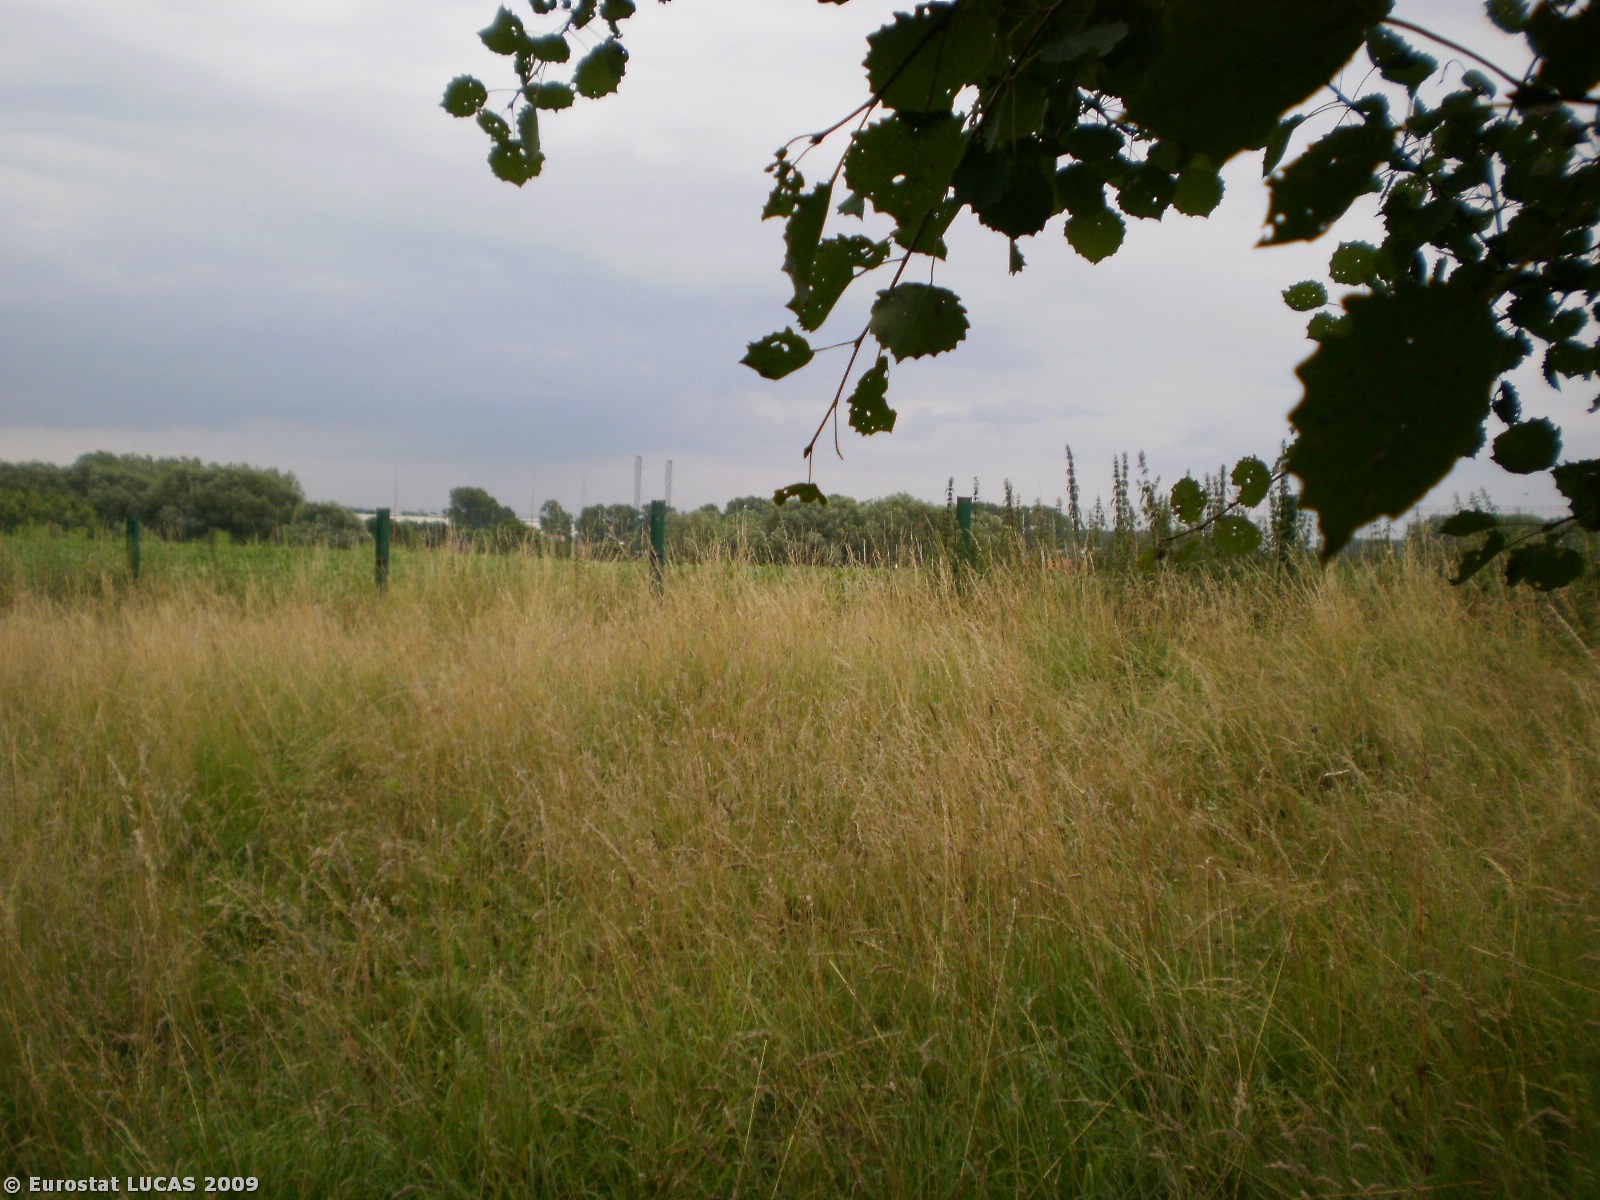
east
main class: Grassland
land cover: Grassland without tree/shrub cover
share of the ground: > 75 %
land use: Agriculture (excluding fallow land and kitchen gardens)
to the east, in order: Grassland without tree/shrub cover; Fences; Sugar beet; Potatoes; Maize
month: July
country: BE
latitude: 50.9202
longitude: 4.2052
